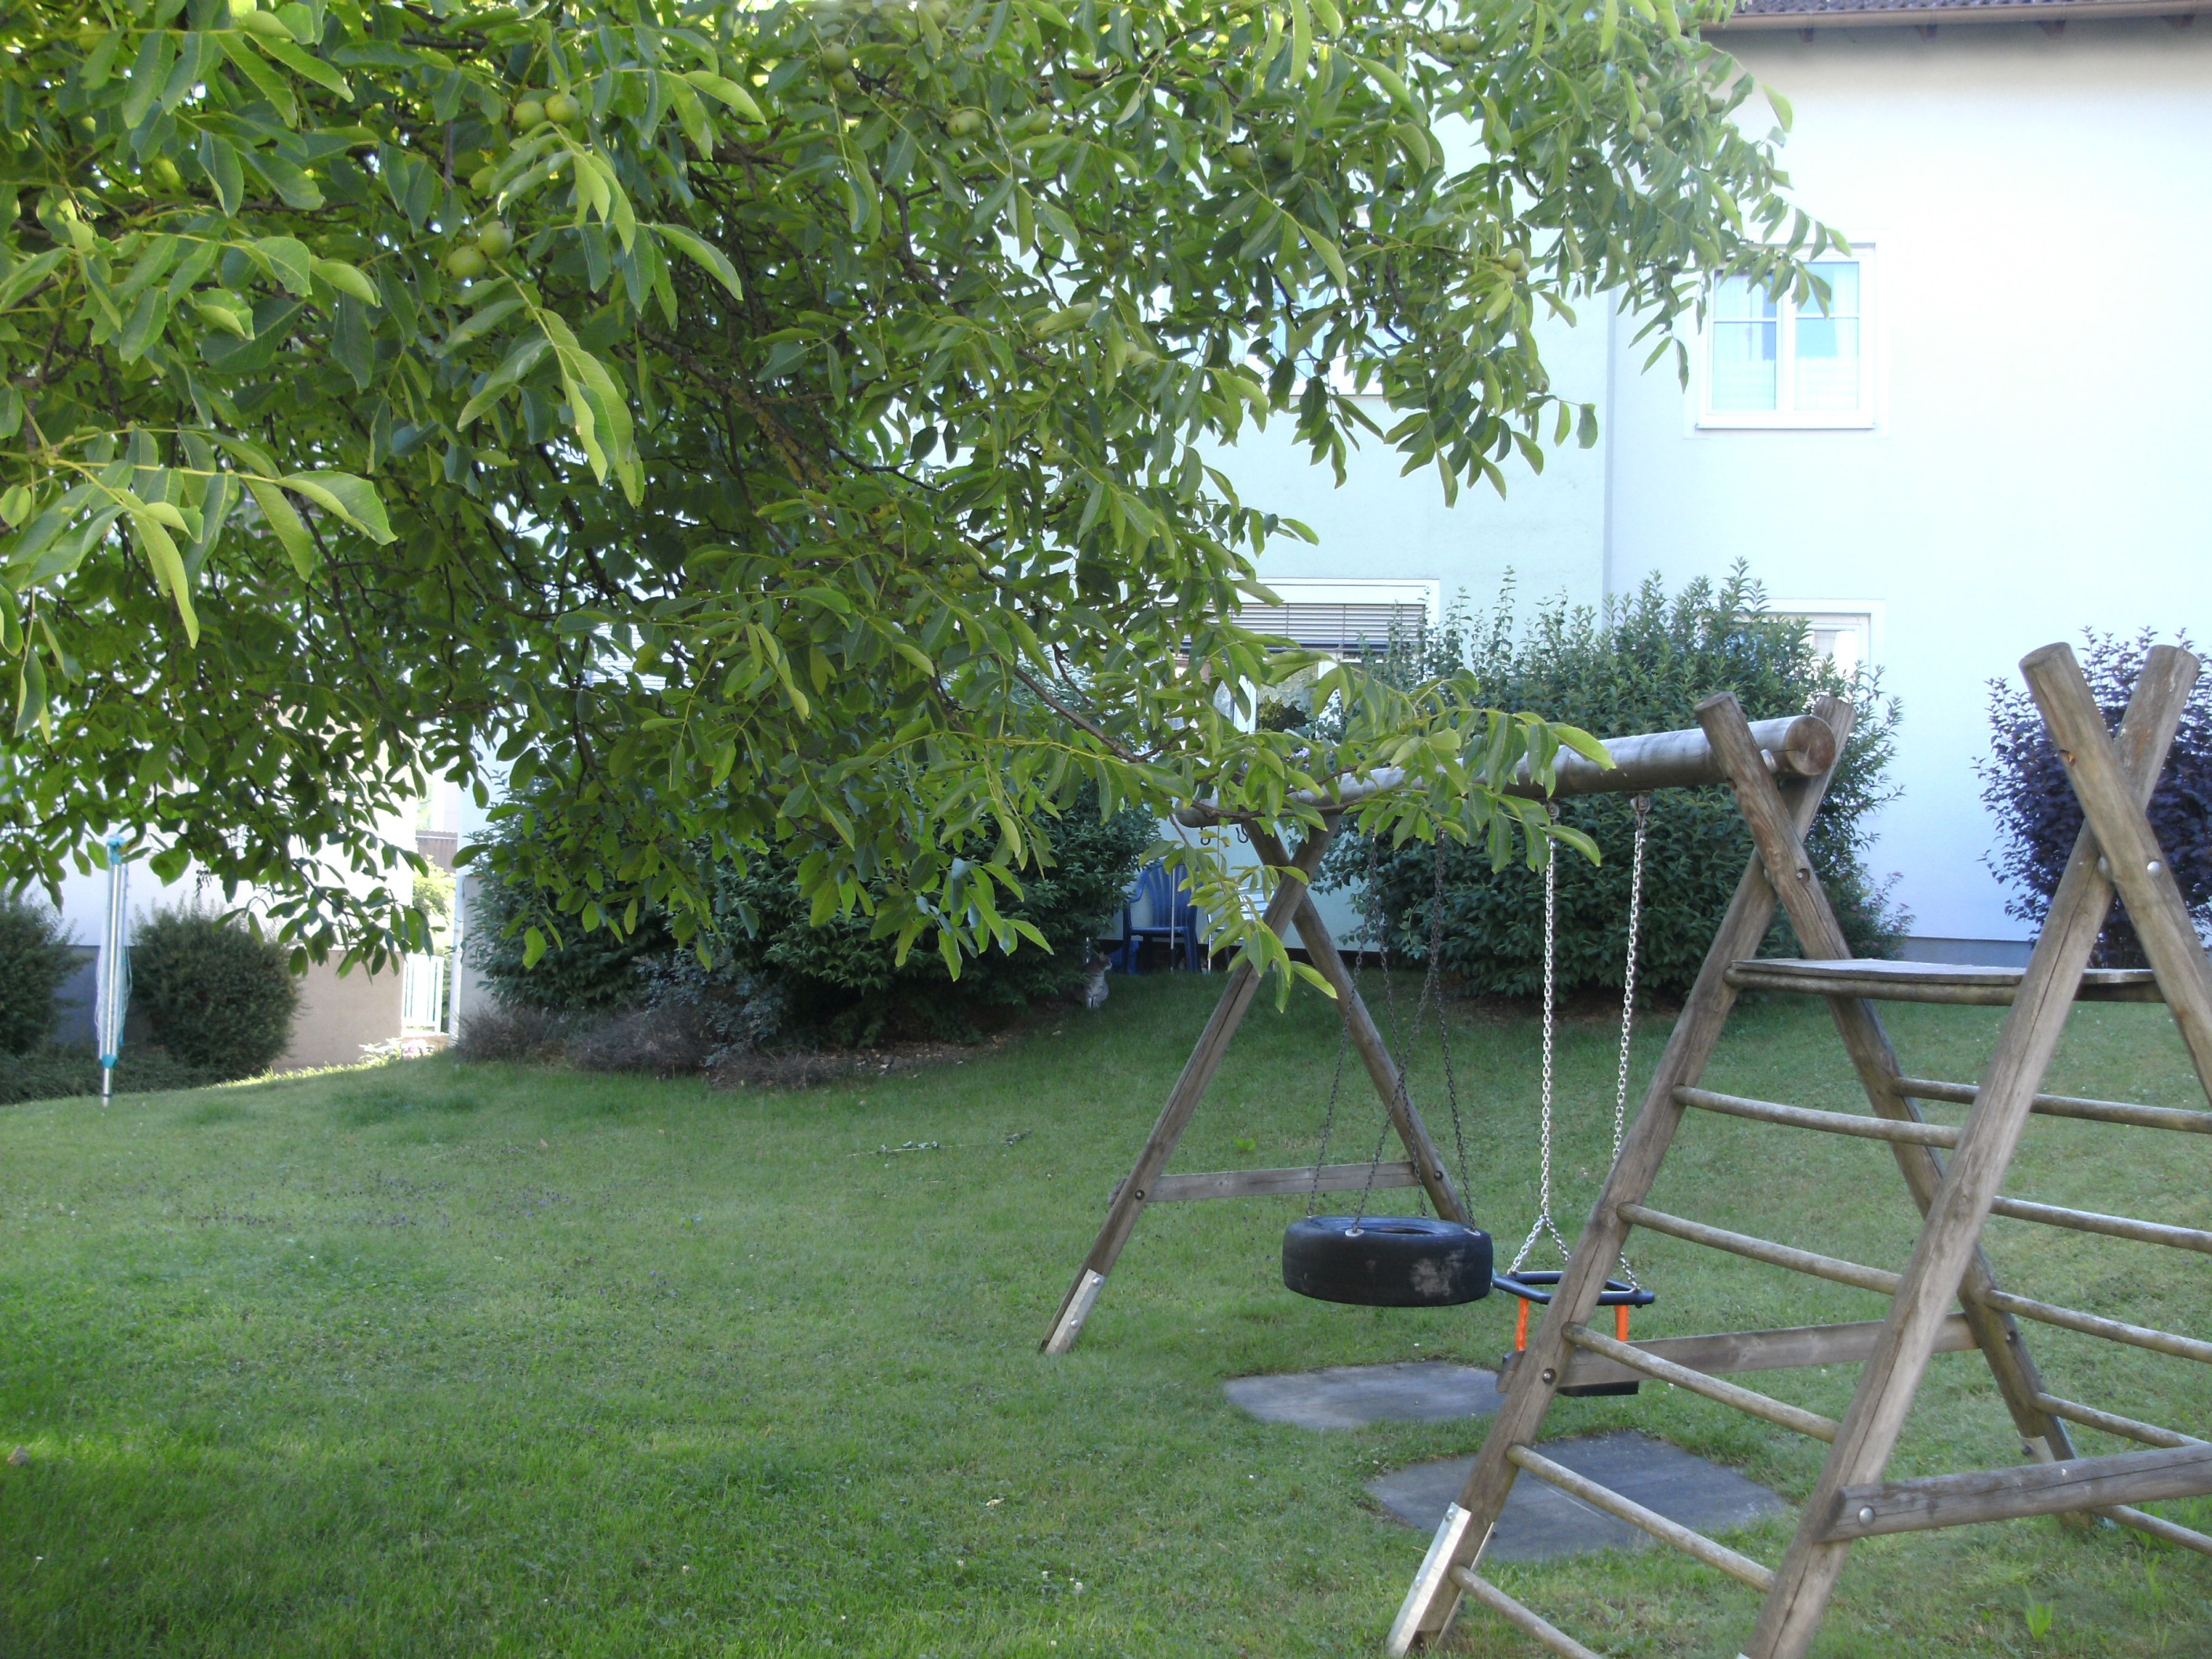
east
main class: Grassland
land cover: Grassland with sparse tree/shrub cover
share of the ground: > 75 %
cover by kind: herbaceous plants 95 %, broadleaved forest trees 5 %
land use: Amenities, museums, leisure
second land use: Residential
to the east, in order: Grassland with sparse tree/shrub cover; Artificial constructions in urban areas
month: July
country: AT
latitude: 48.2045
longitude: 13.4843
